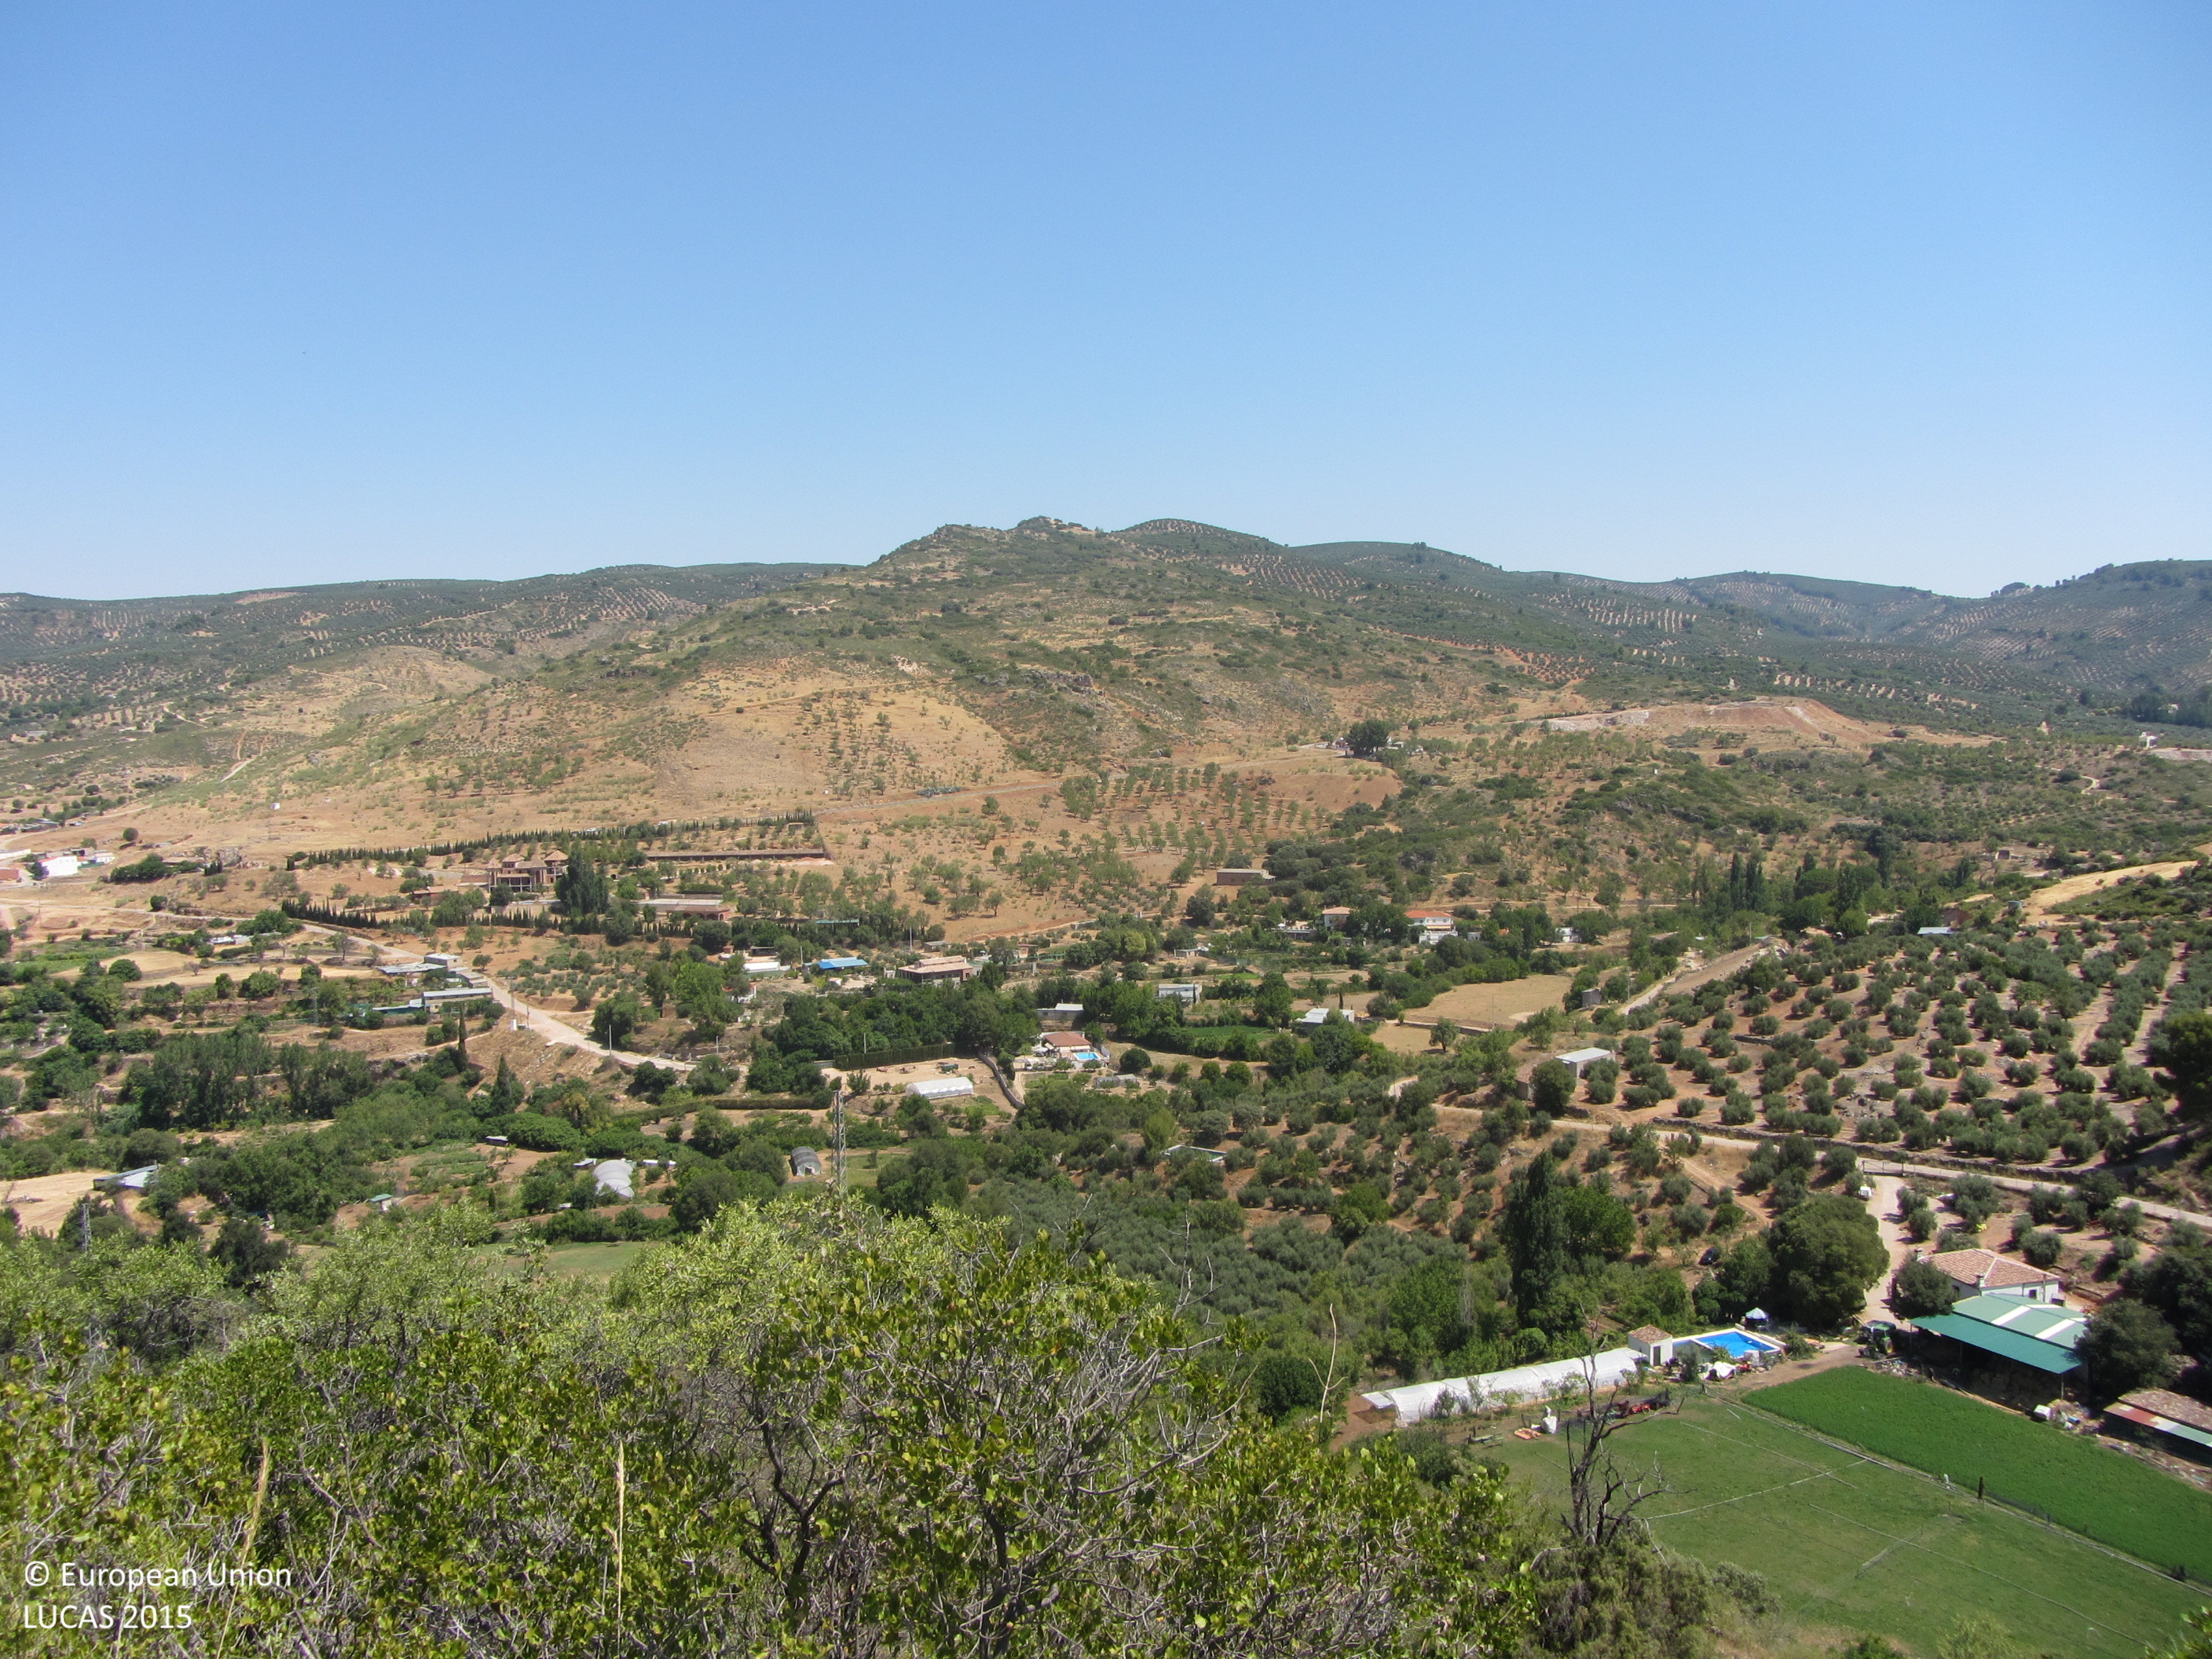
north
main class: Shrubland
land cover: Shrubland with sparse tree cover
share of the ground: > 75 %
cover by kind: shrubs 95 %, coniferous forest trees 5 %
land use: Semi-natural and natural areas not in use
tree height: < 5 m
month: June
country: ES
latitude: 38.2432
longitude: -2.8757
